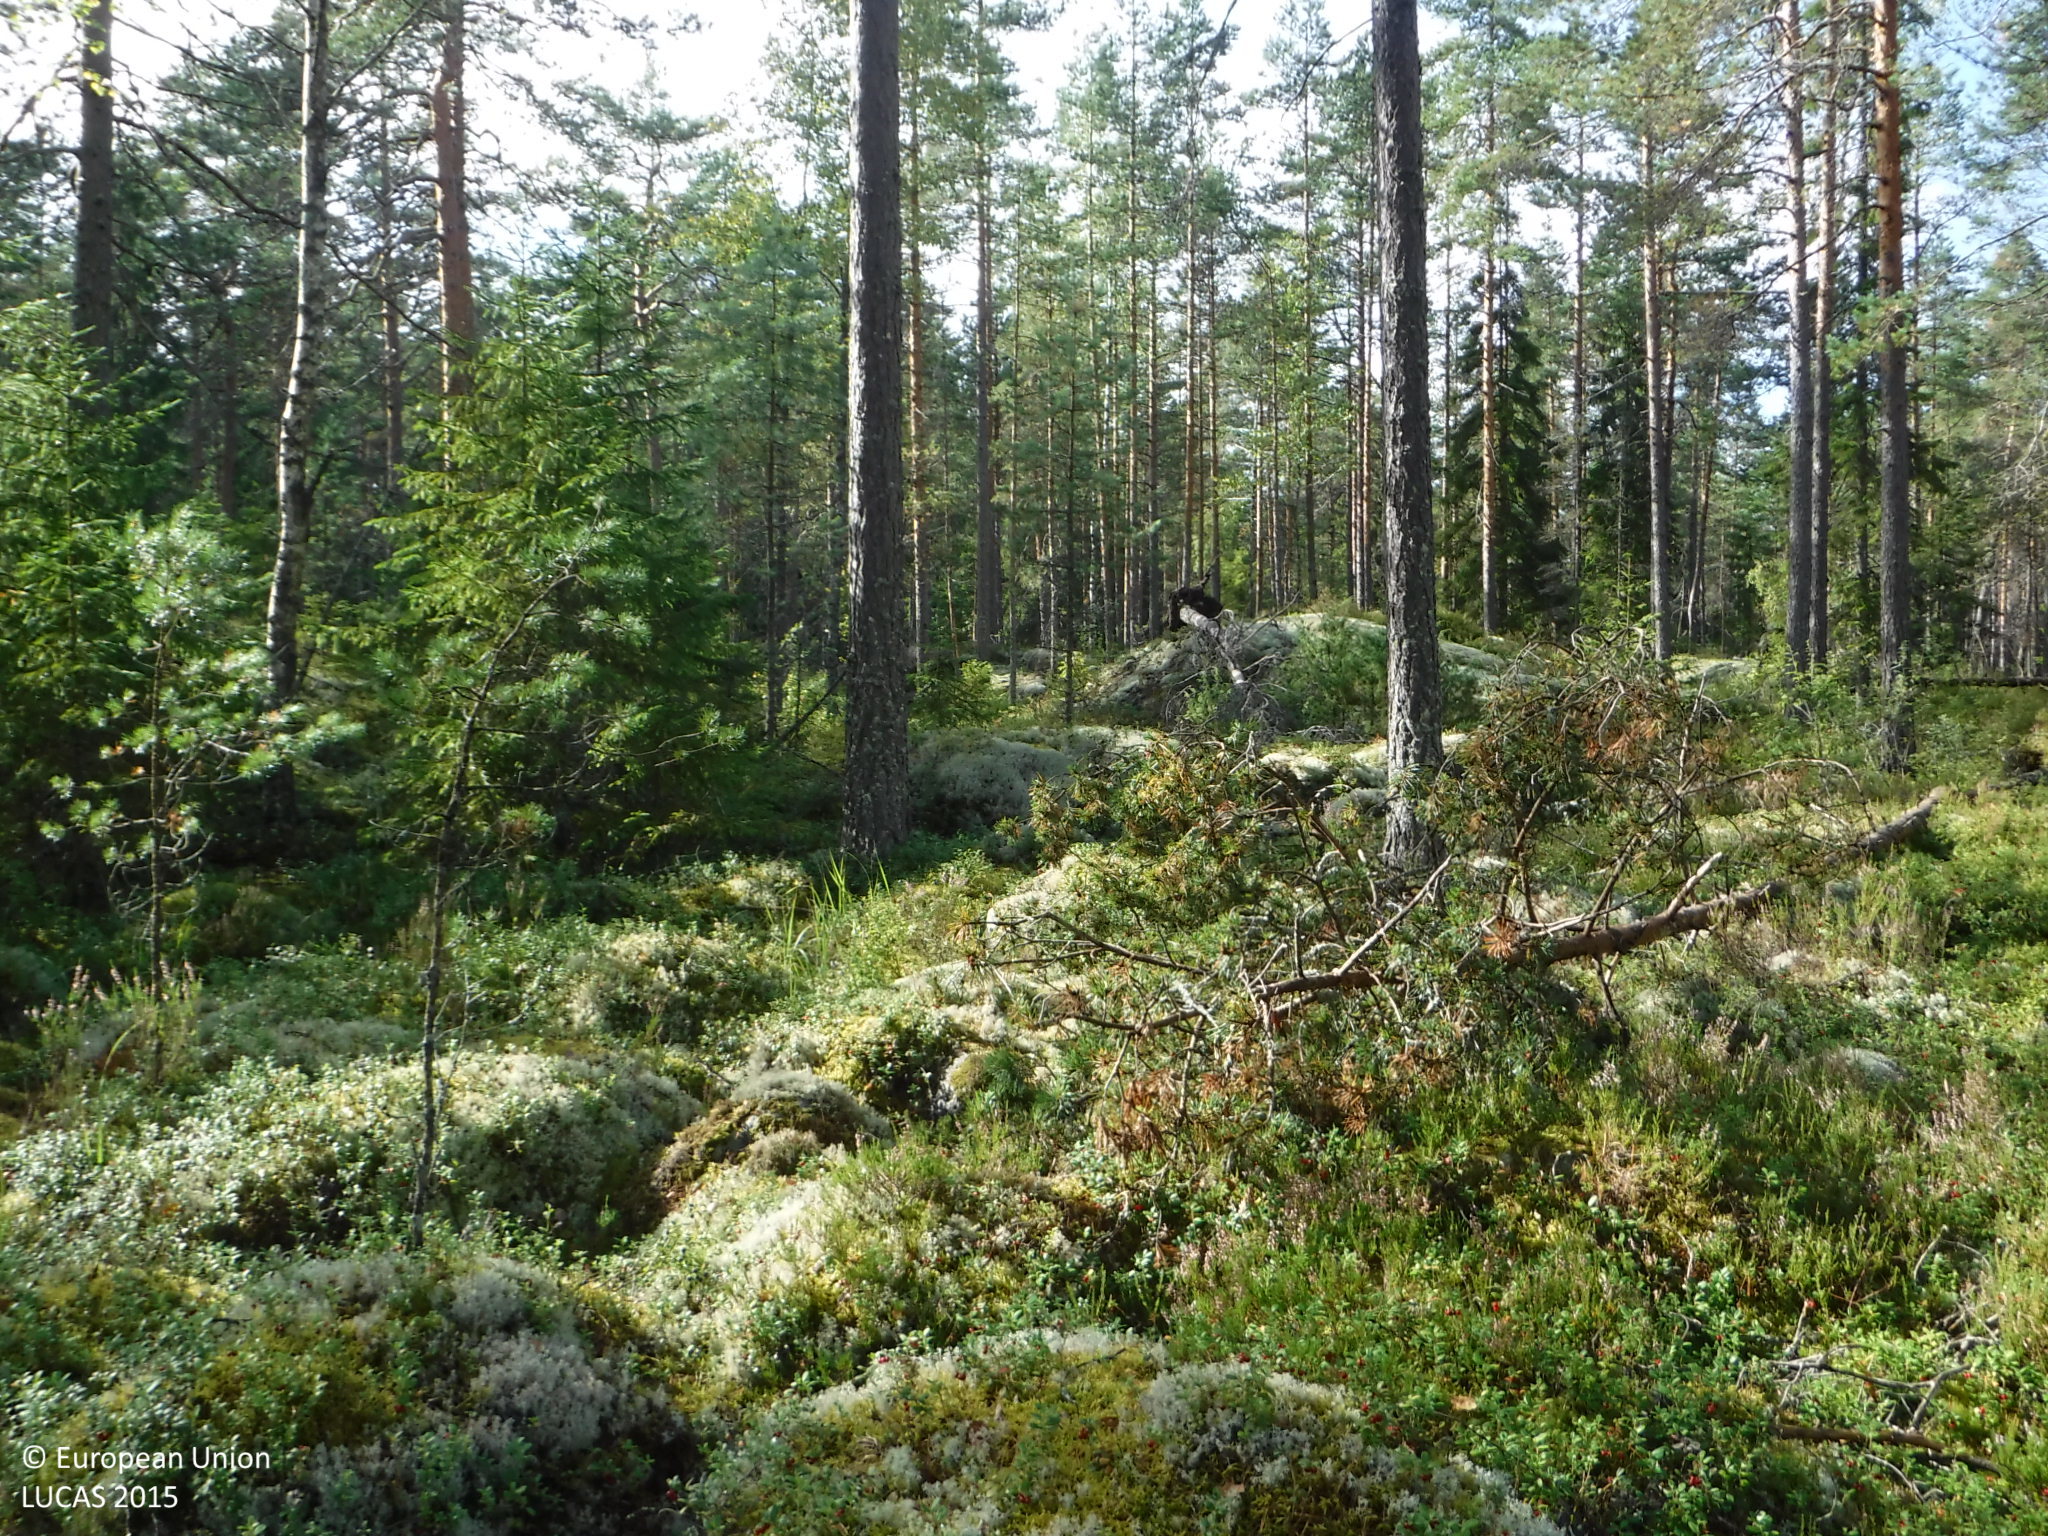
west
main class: Woodland
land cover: Pine dominated coniferous woodland
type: boreal forest
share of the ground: 25 - 50 %
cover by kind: lichens and mosses 45 %, coniferous forest trees 30 %, shrubs 25 %
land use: Forestry
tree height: > 5 m
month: September
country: FI
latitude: 61.3656
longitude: 22.6179
